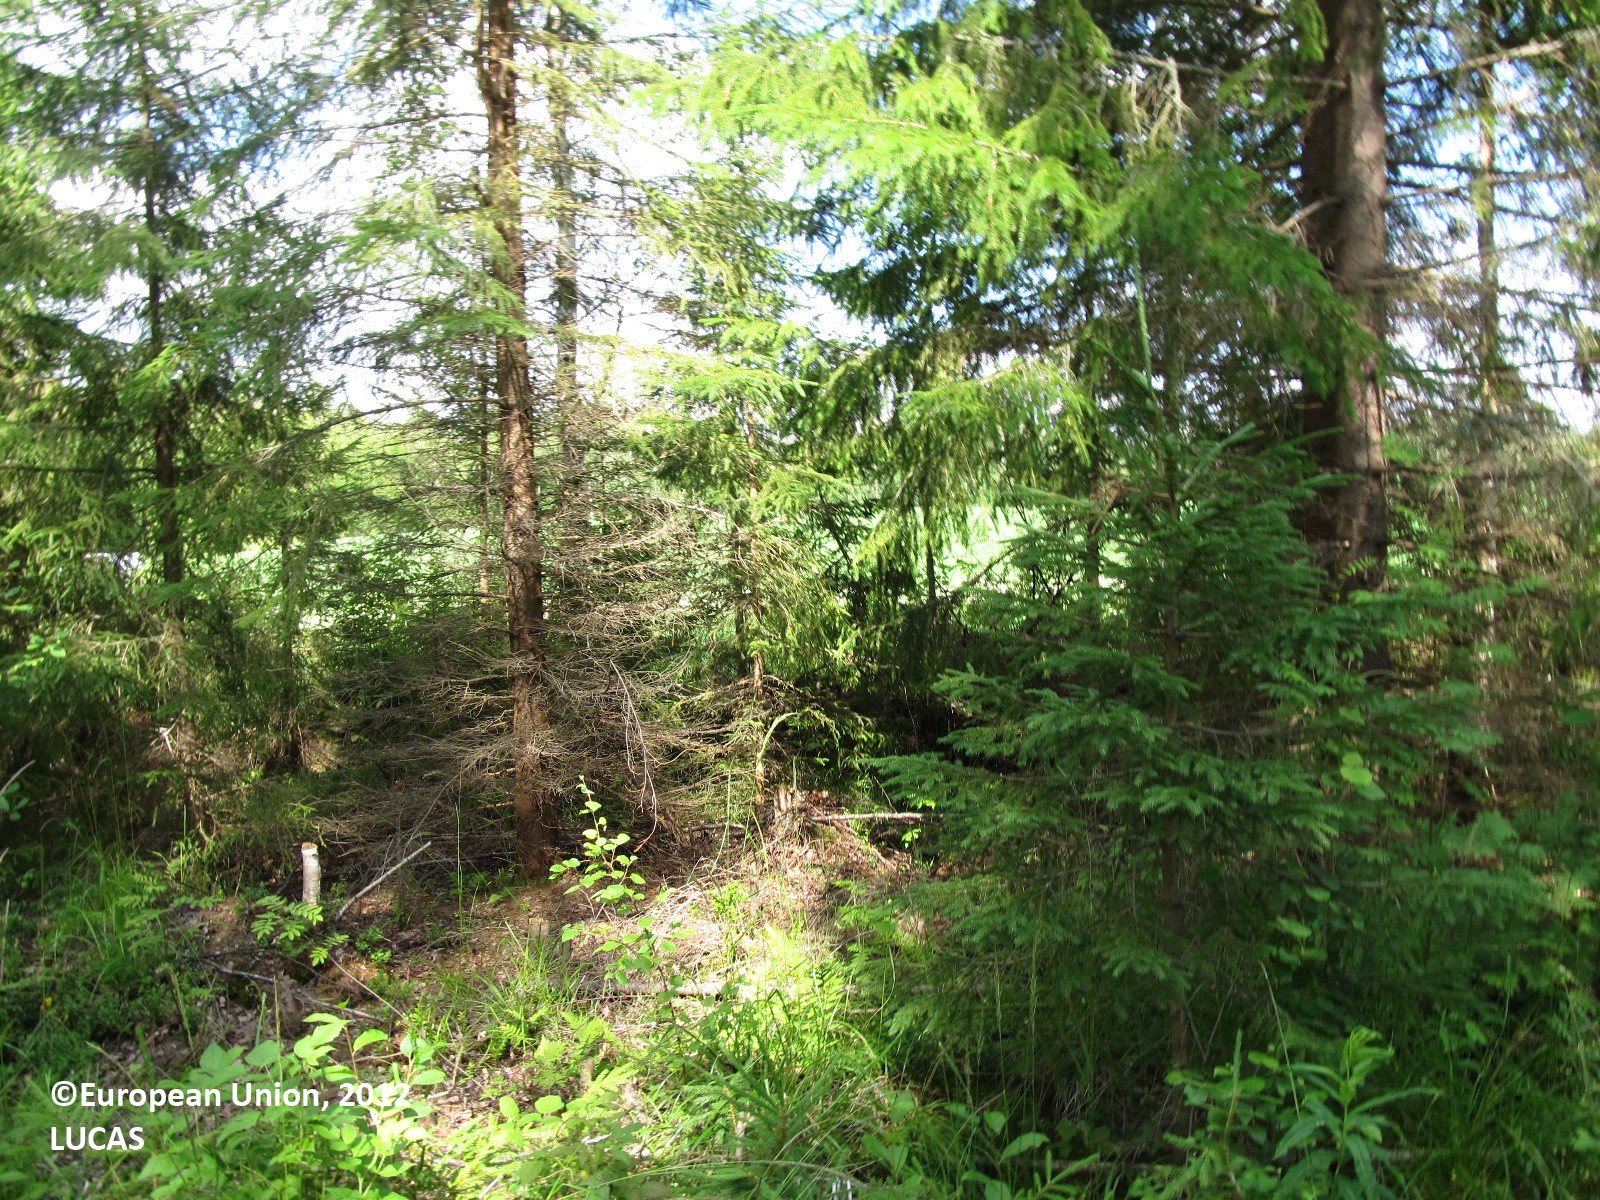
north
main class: Woodland
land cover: Spruce dominated mixed woodland
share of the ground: 25 - 50 %
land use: Forestry
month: July
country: FI
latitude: 61.9323
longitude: 28.3585
